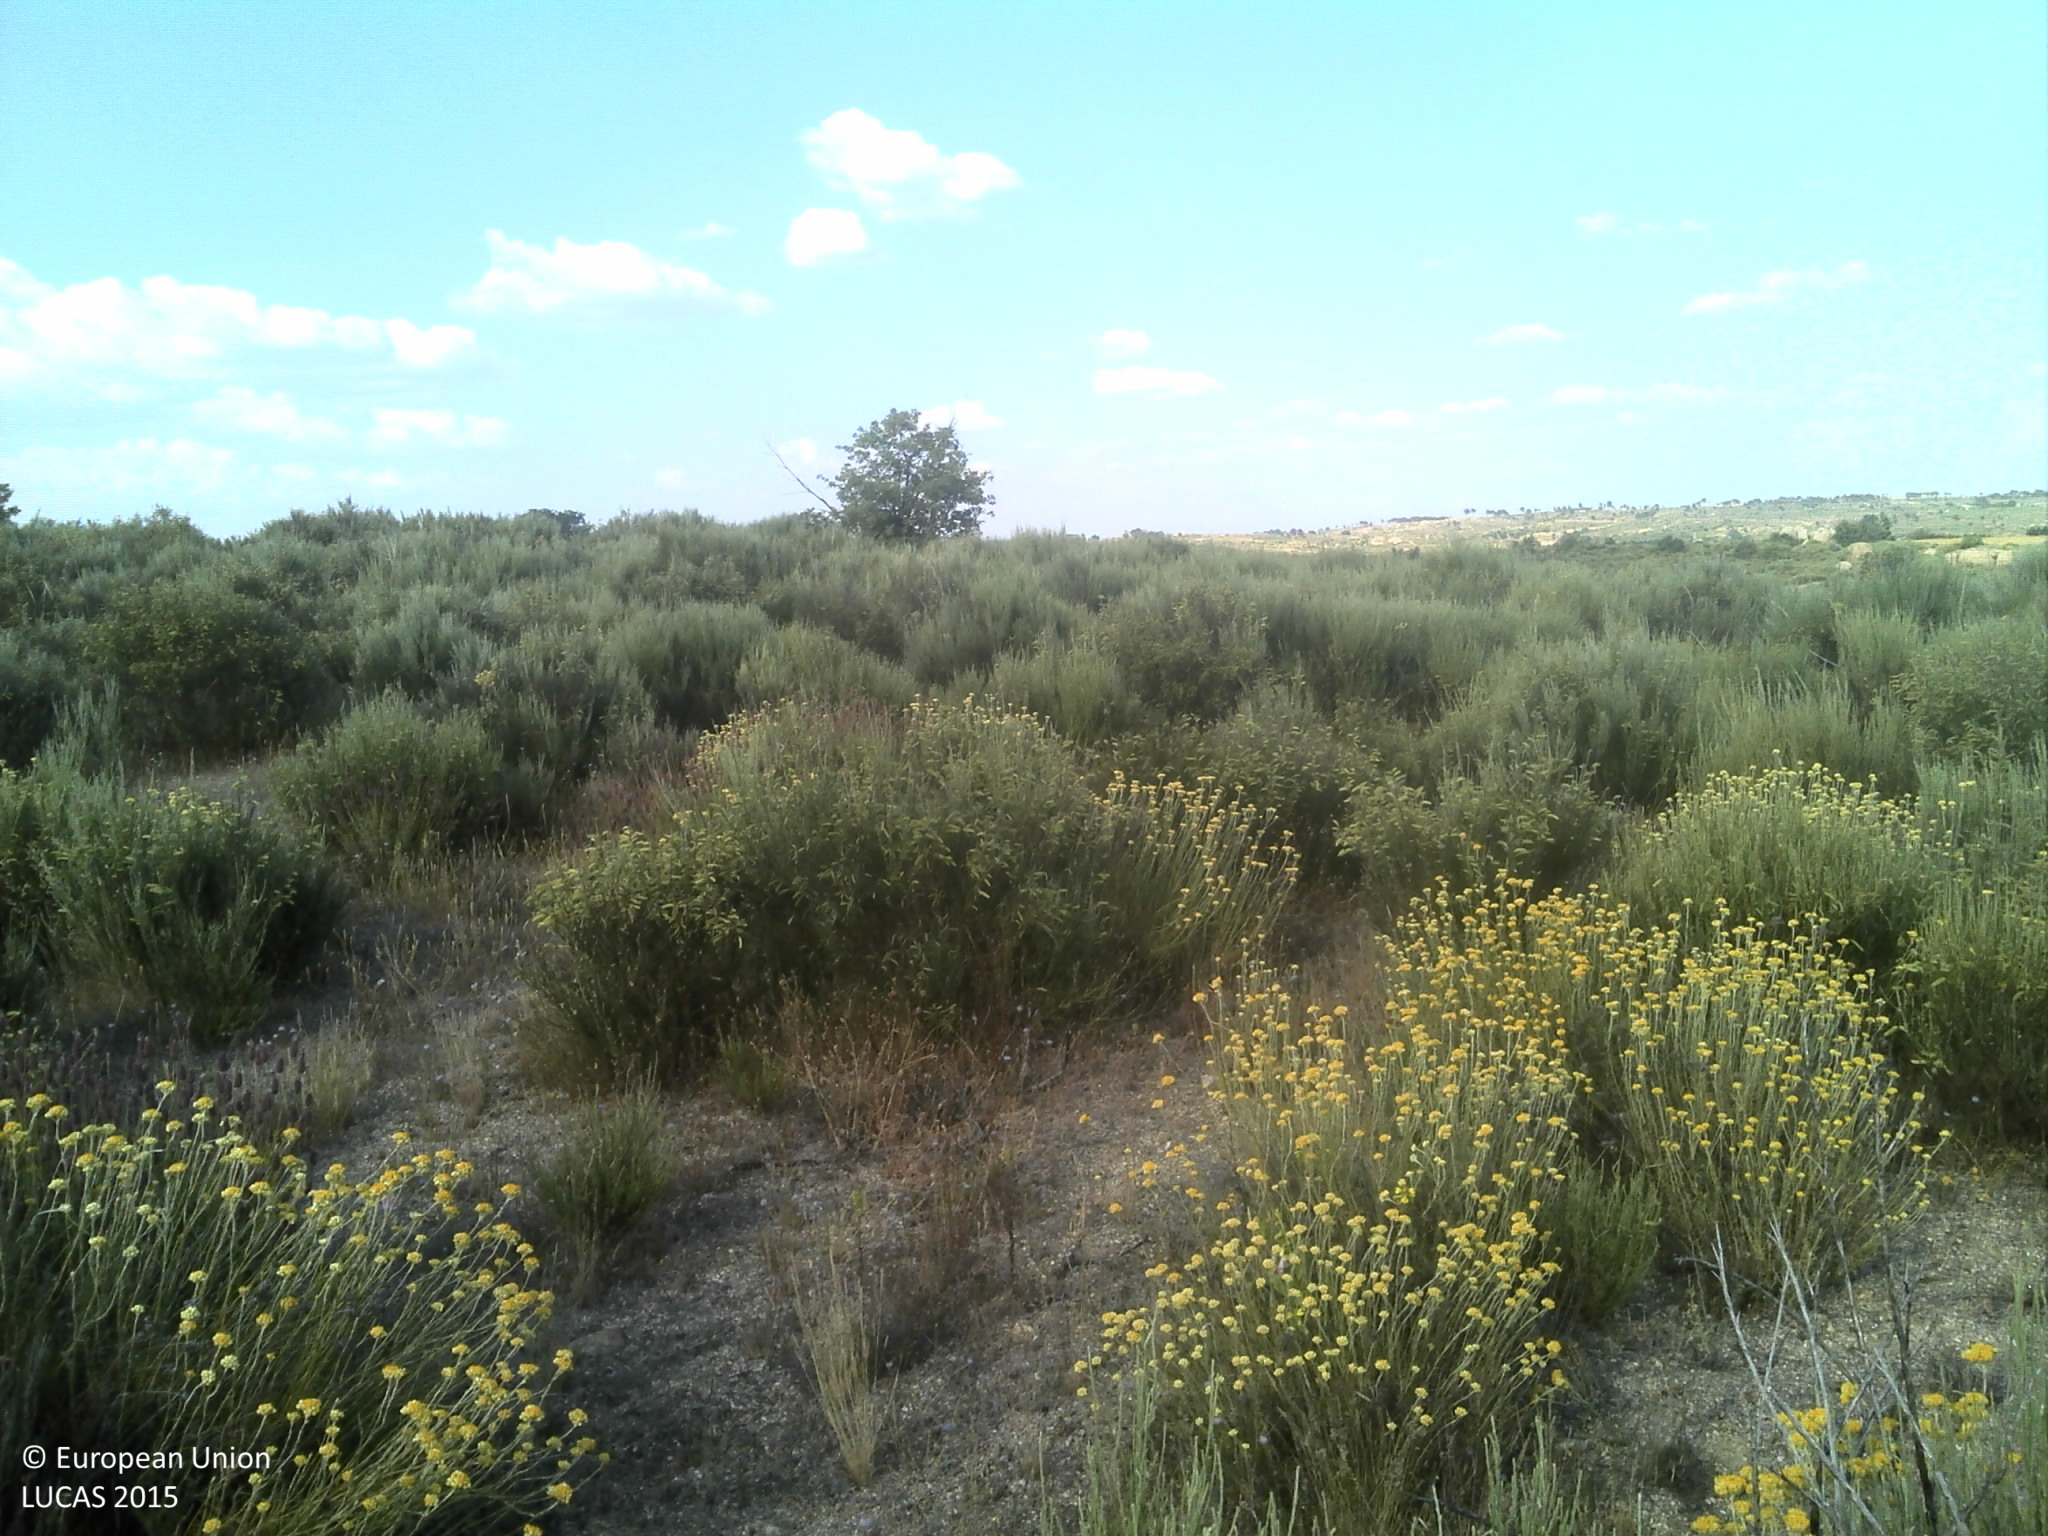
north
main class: Shrubland
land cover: Shrubland without tree cover
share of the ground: 50 - 75 %
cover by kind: shrubs 65 %, unconsolidated bare surface 15 %, herbaceous plants 10 %, consolidated bare surface 10 %
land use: Semi-natural and natural areas not in use
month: June
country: PT
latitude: 40.4948
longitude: -7.0550
